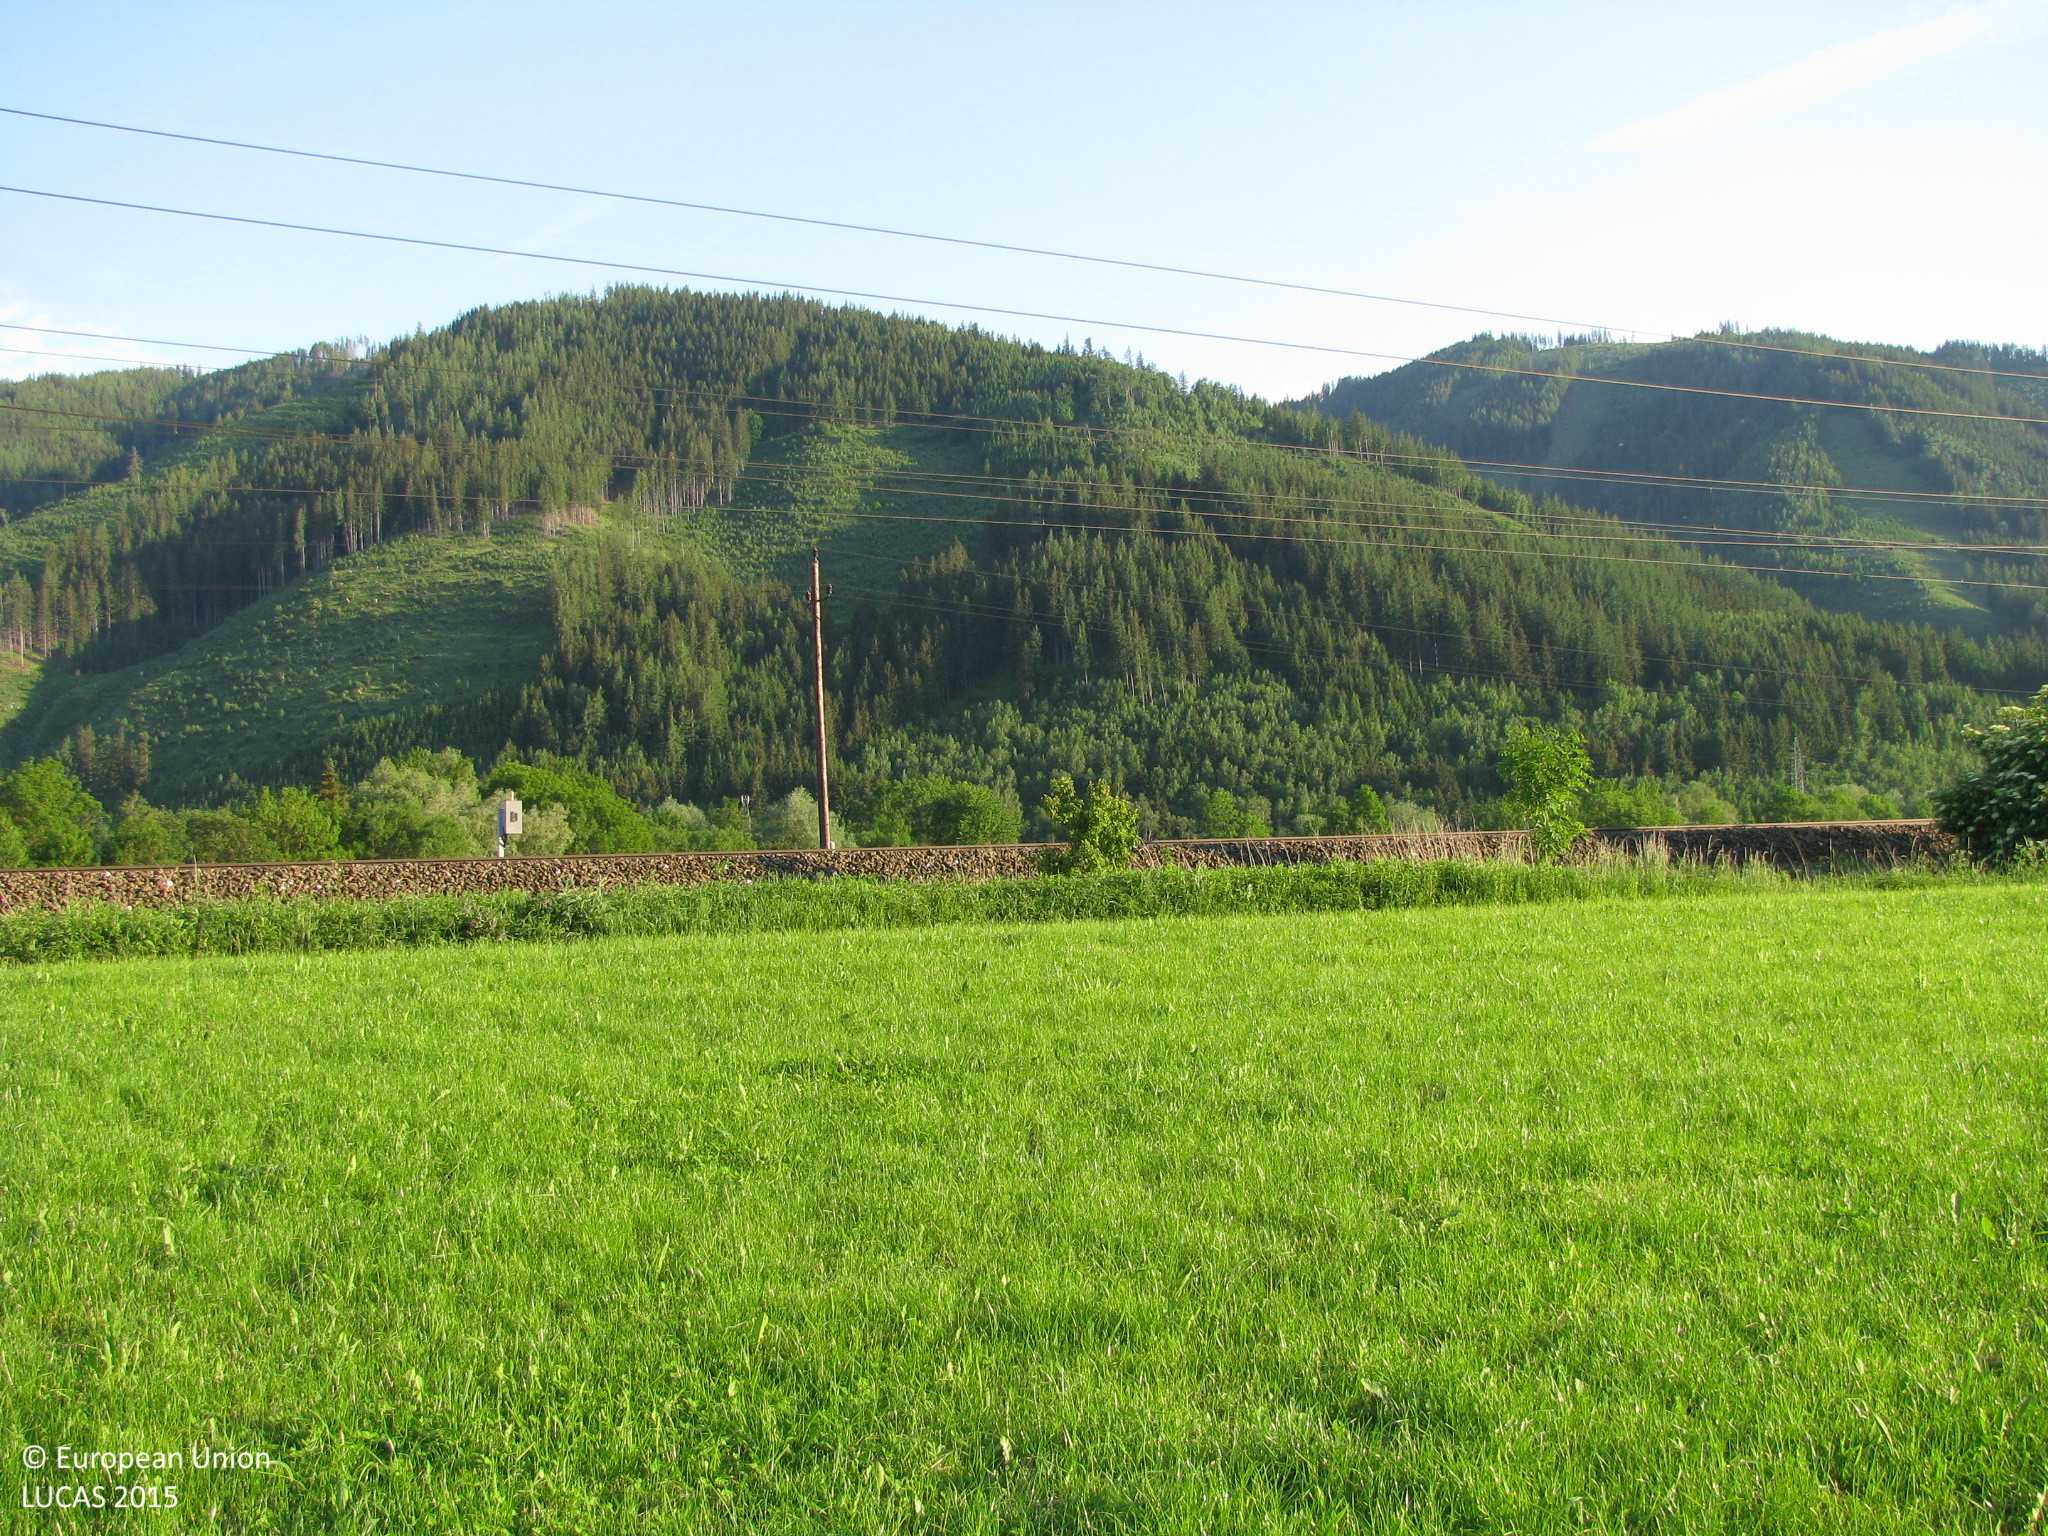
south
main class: Grassland
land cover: Grassland without tree/shrub cover
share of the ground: > 75 %
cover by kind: herbaceous plants 100 %
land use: Agriculture (excluding fallow land and kitchen gardens)
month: June
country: AT
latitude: 47.3927
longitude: 14.9147
